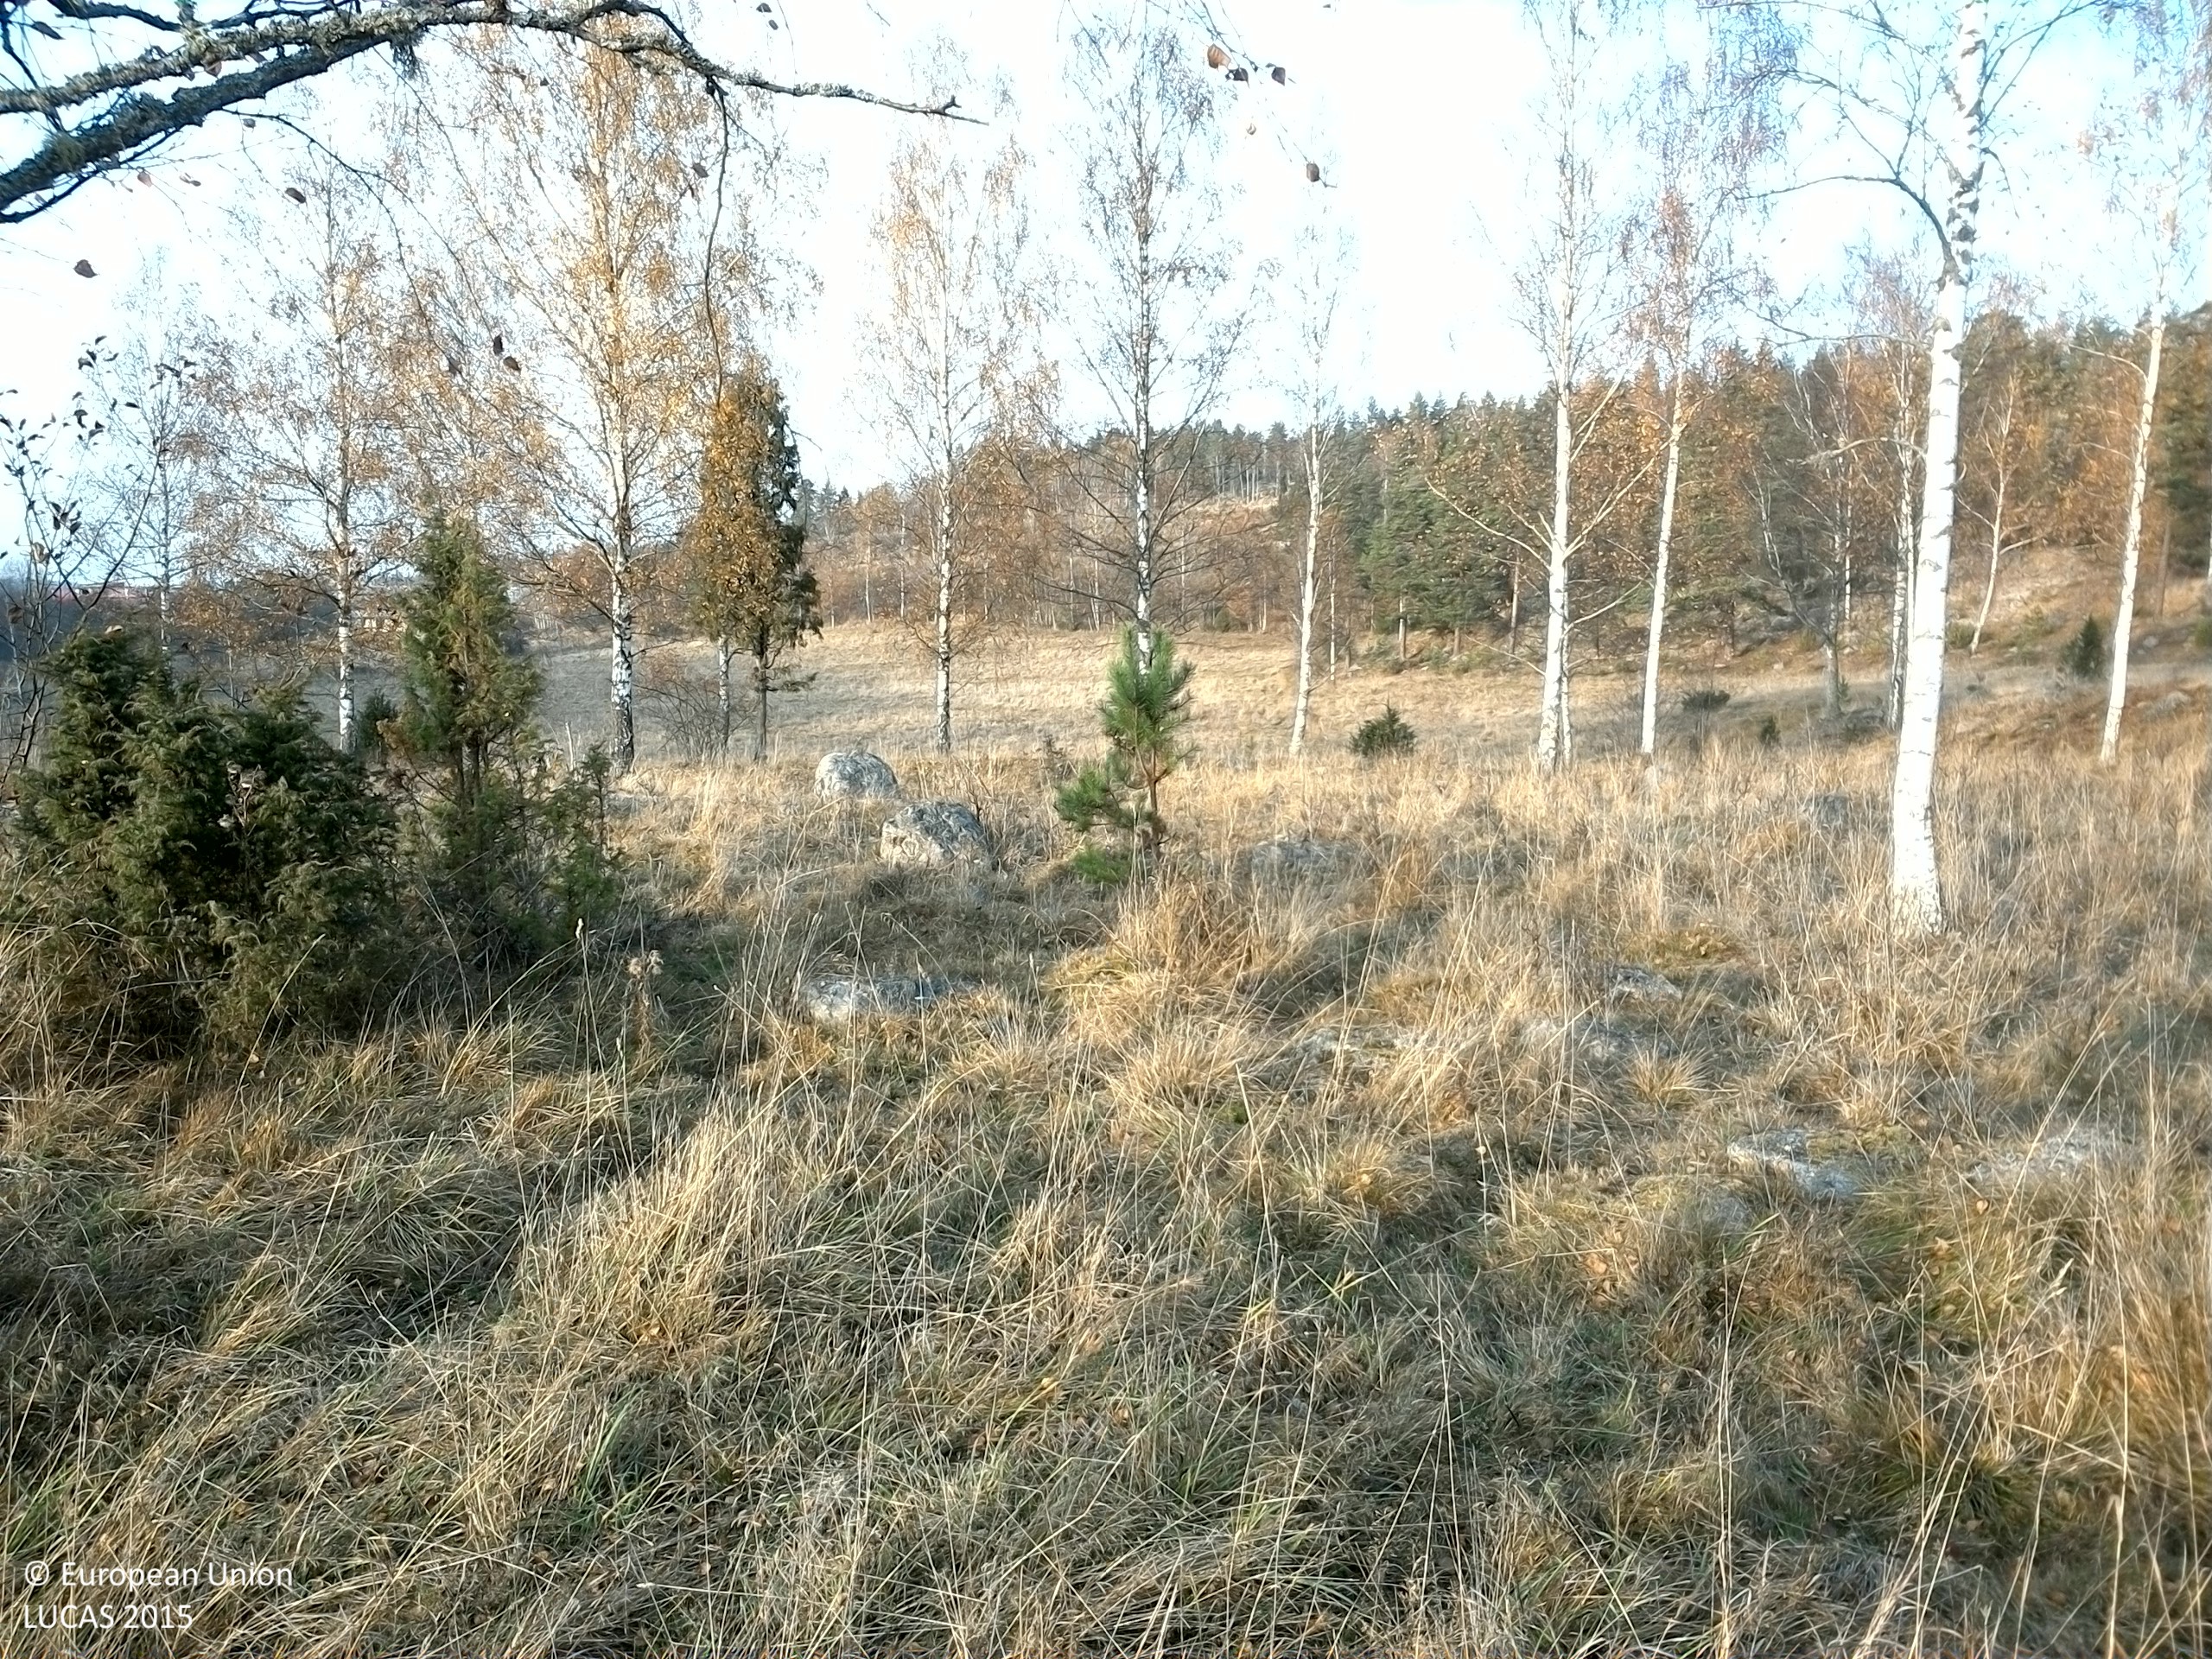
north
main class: Grassland
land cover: Grassland with sparse tree/shrub cover
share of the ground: > 75 %
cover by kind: herbaceous plants 90 %, broadleaved forest trees 5 %, shrubs 5 %
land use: Agriculture (excluding fallow land and kitchen gardens)
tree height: > 5 m
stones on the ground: < 10 %
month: October
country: SE
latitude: 59.2409
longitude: 17.1300
